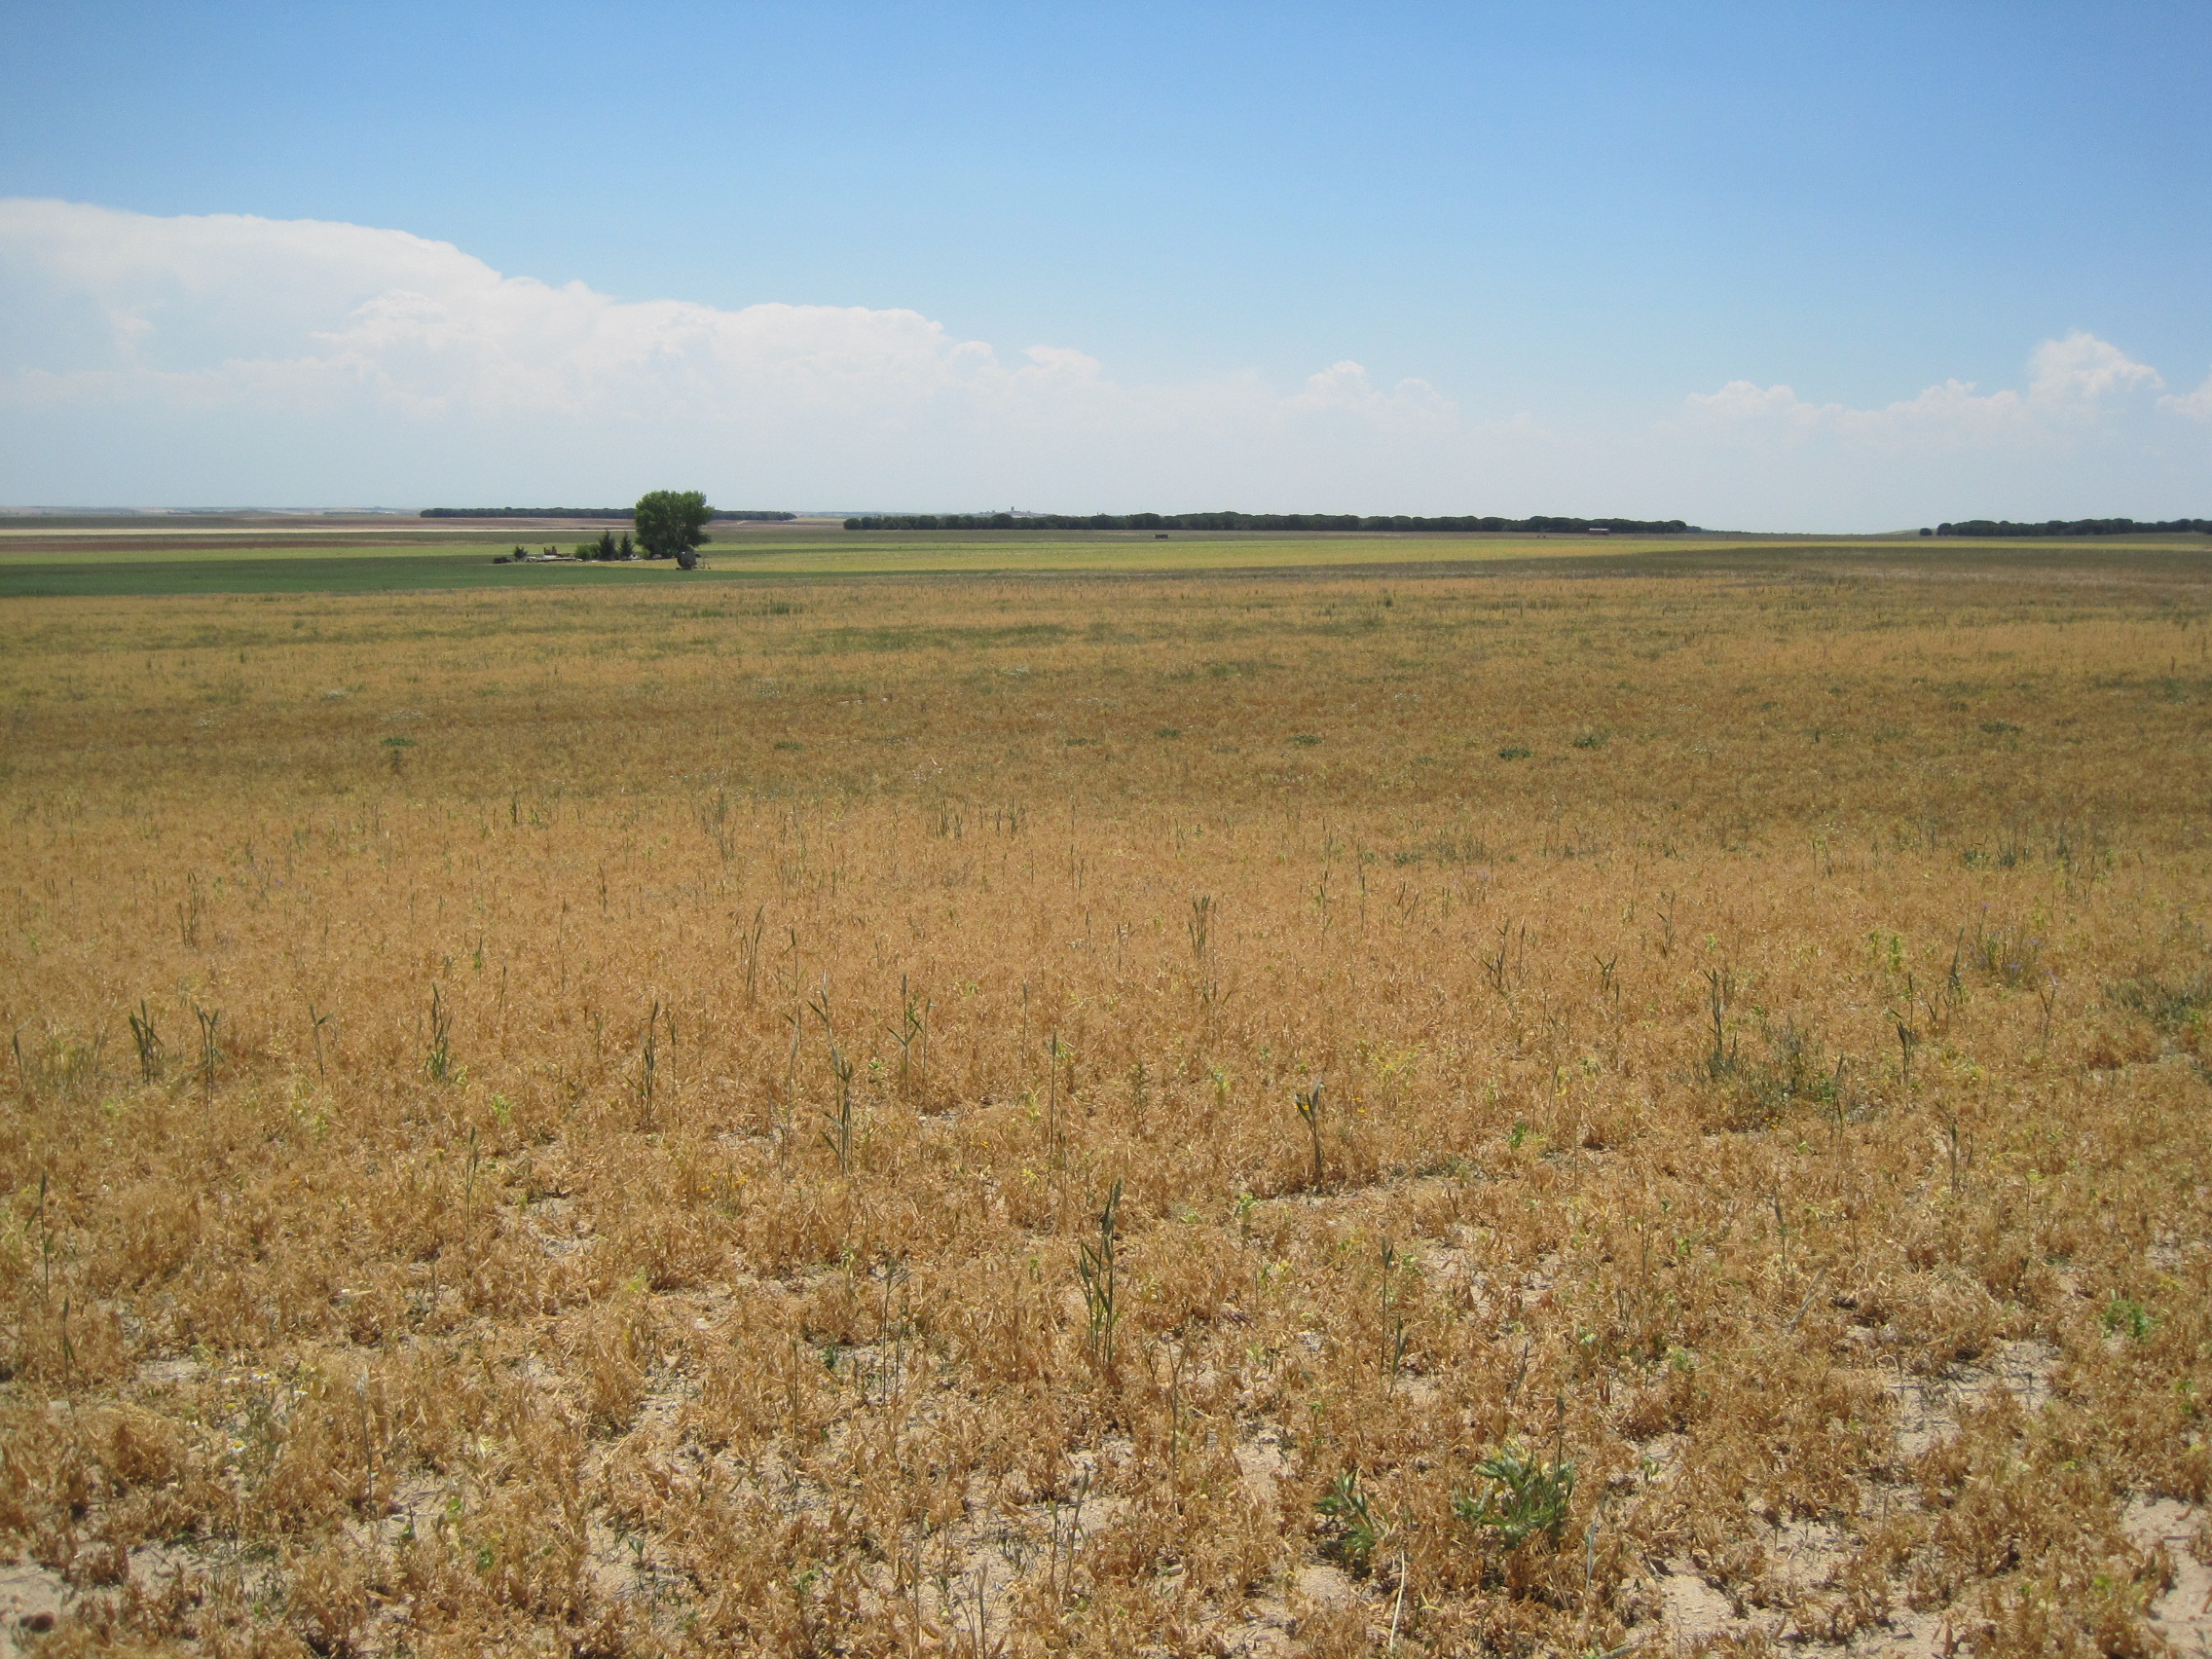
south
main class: Cropland
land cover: Dry pulses
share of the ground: > 75 %
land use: Agriculture (excluding fallow land and kitchen gardens)
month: May
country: ES
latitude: 41.2758
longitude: -5.1013
